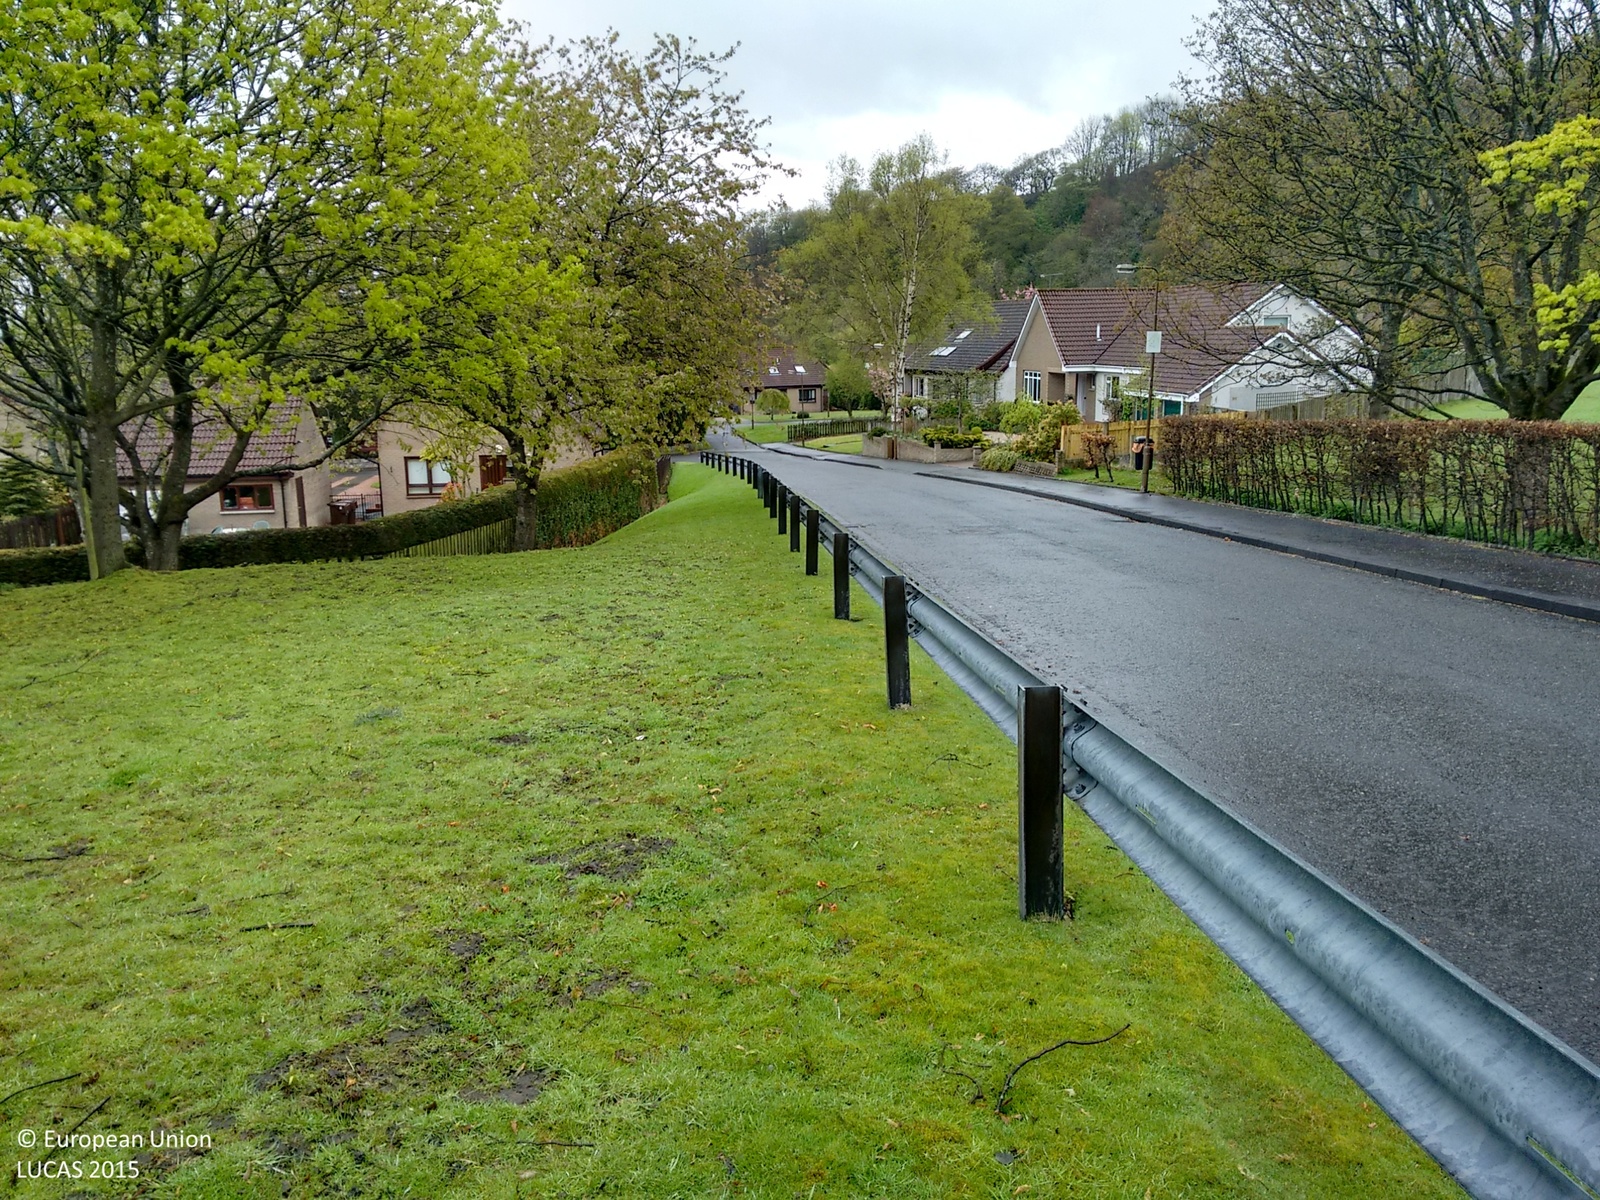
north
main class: Grassland
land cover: Grassland without tree/shrub cover
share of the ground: > 75 %
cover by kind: herbaceous plants 95 %, lichens and mosses 5 %
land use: Road transport
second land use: Residential
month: May
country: GB
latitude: 56.1136
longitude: -3.9648
